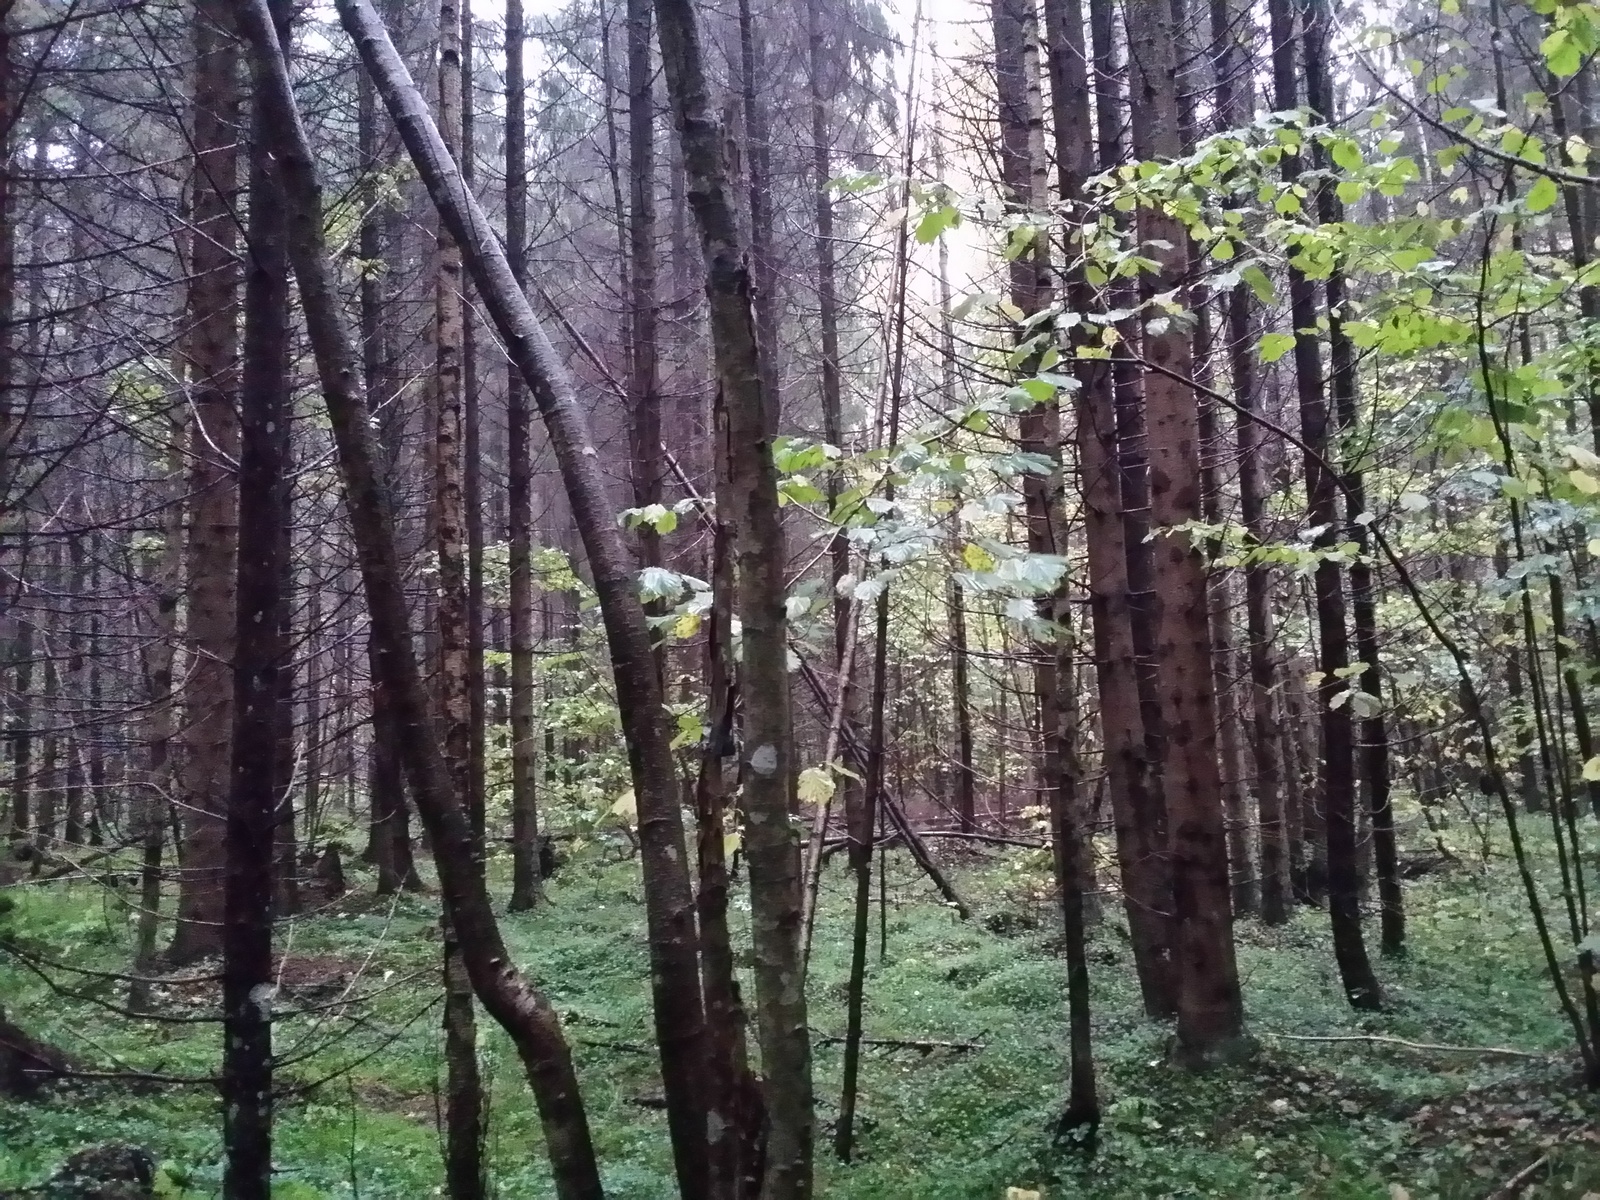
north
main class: Woodland
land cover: Spruce dominated coniferous woodland
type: hemiboreal forest and nemoral coniferous forest and mixed broadleaved-coniferous forest
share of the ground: > 75 %
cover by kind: coniferous forest trees 75 %, broadleaved forest trees 15 %, herbaceous plants 5 %, lichens and mosses 5 %
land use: Forestry
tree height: > 5 m
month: September
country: LV
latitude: 57.4597
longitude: 27.3894
